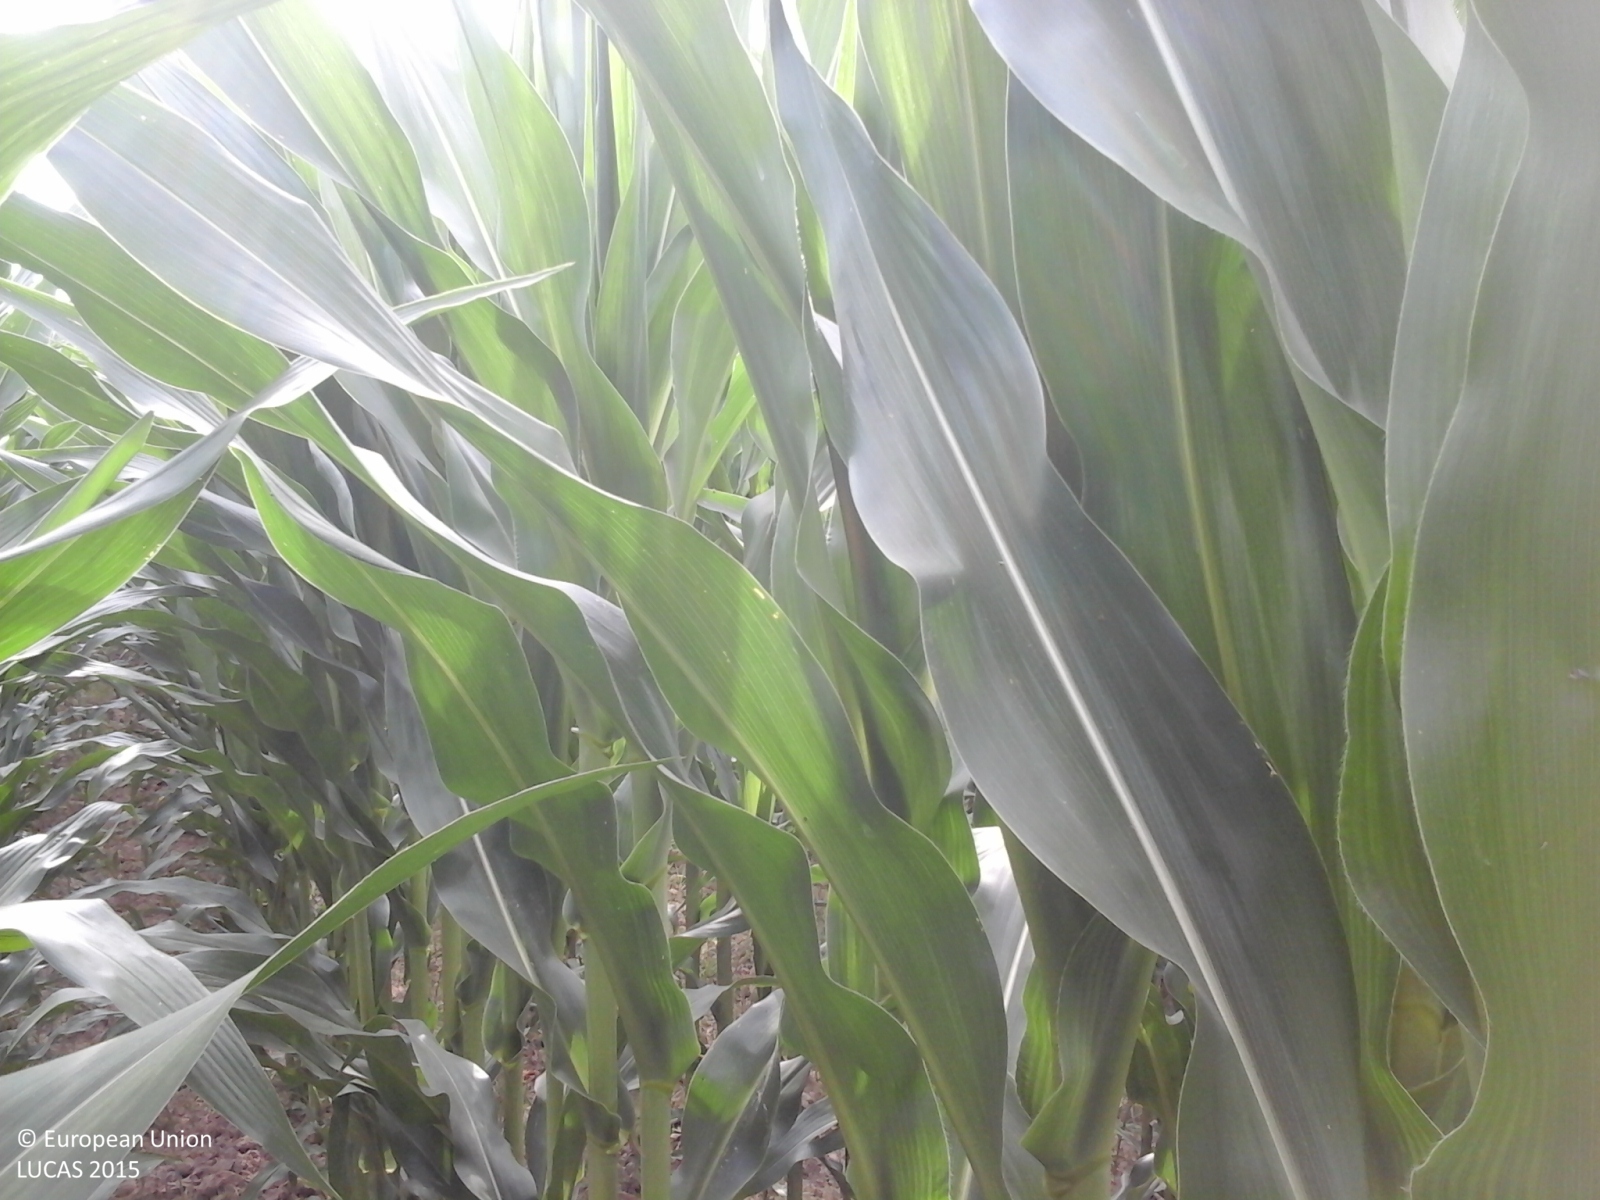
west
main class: Cropland
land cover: Maize
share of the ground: > 75 %
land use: Agriculture (excluding fallow land and kitchen gardens)
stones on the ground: < 10 %
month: June
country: IT
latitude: 45.2274
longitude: 11.1823
